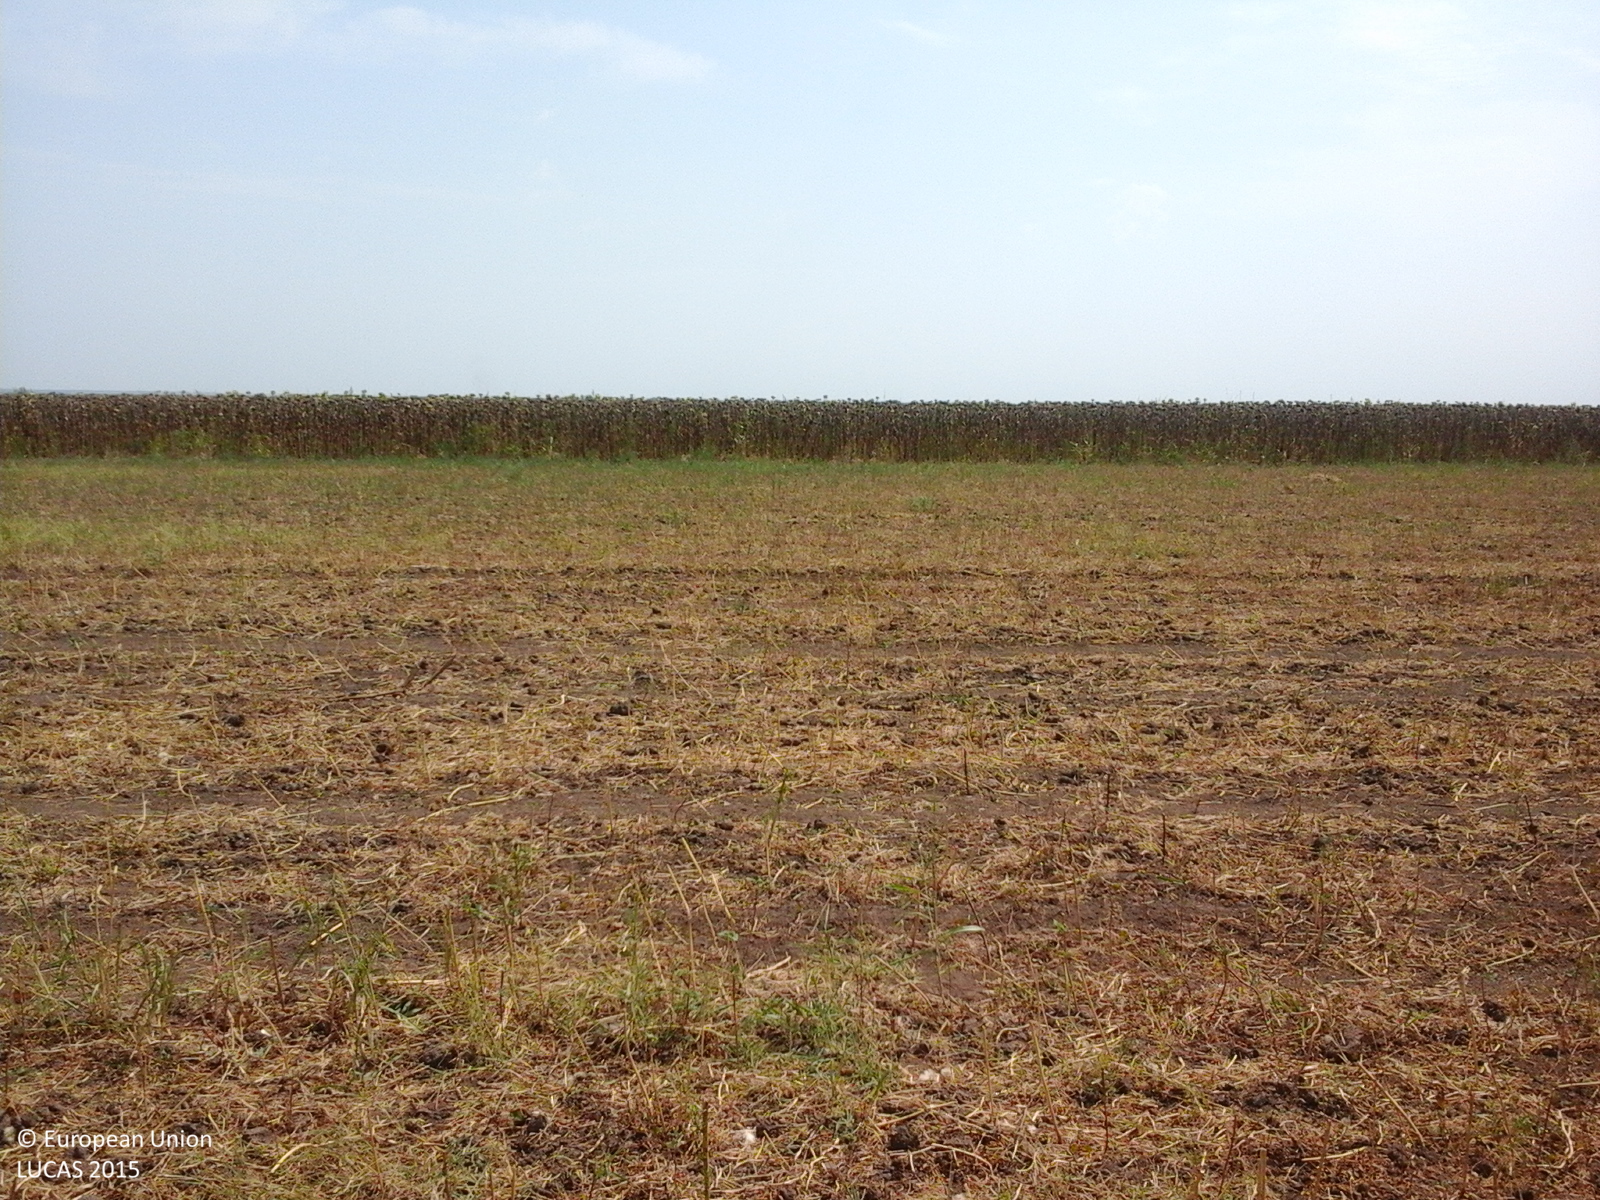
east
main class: Cropland
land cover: Common wheat
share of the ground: 25 - 50 %
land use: Agriculture (excluding fallow land and kitchen gardens)
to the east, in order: Common wheat; Sunflower
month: August
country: RO
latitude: 44.0941
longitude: 23.1471
